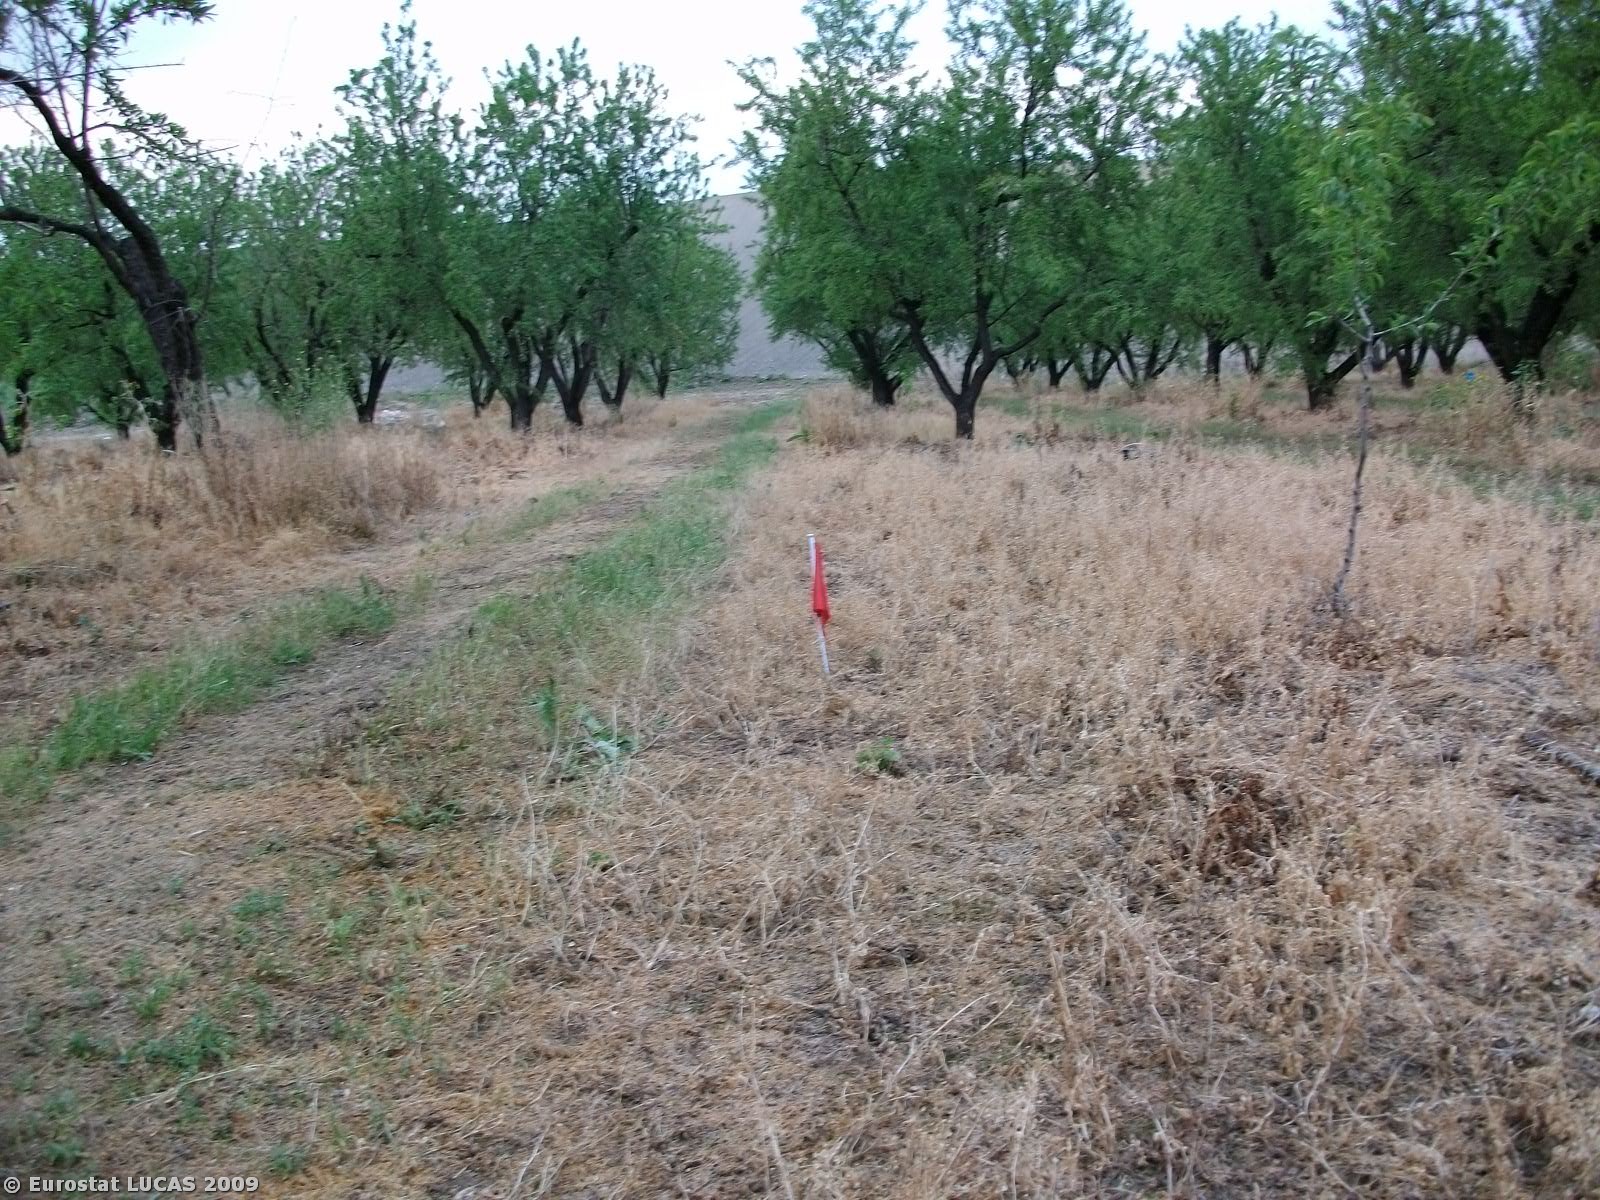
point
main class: Cropland
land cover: Nuts trees
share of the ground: > 75 %
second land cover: Grassland with sparse tree/shrub cover
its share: 10 - 25 %
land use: Agriculture (excluding fallow land and kitchen gardens)
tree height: > 5 m
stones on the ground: < 10 %
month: April
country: GR
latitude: 39.4488
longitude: 22.4800
